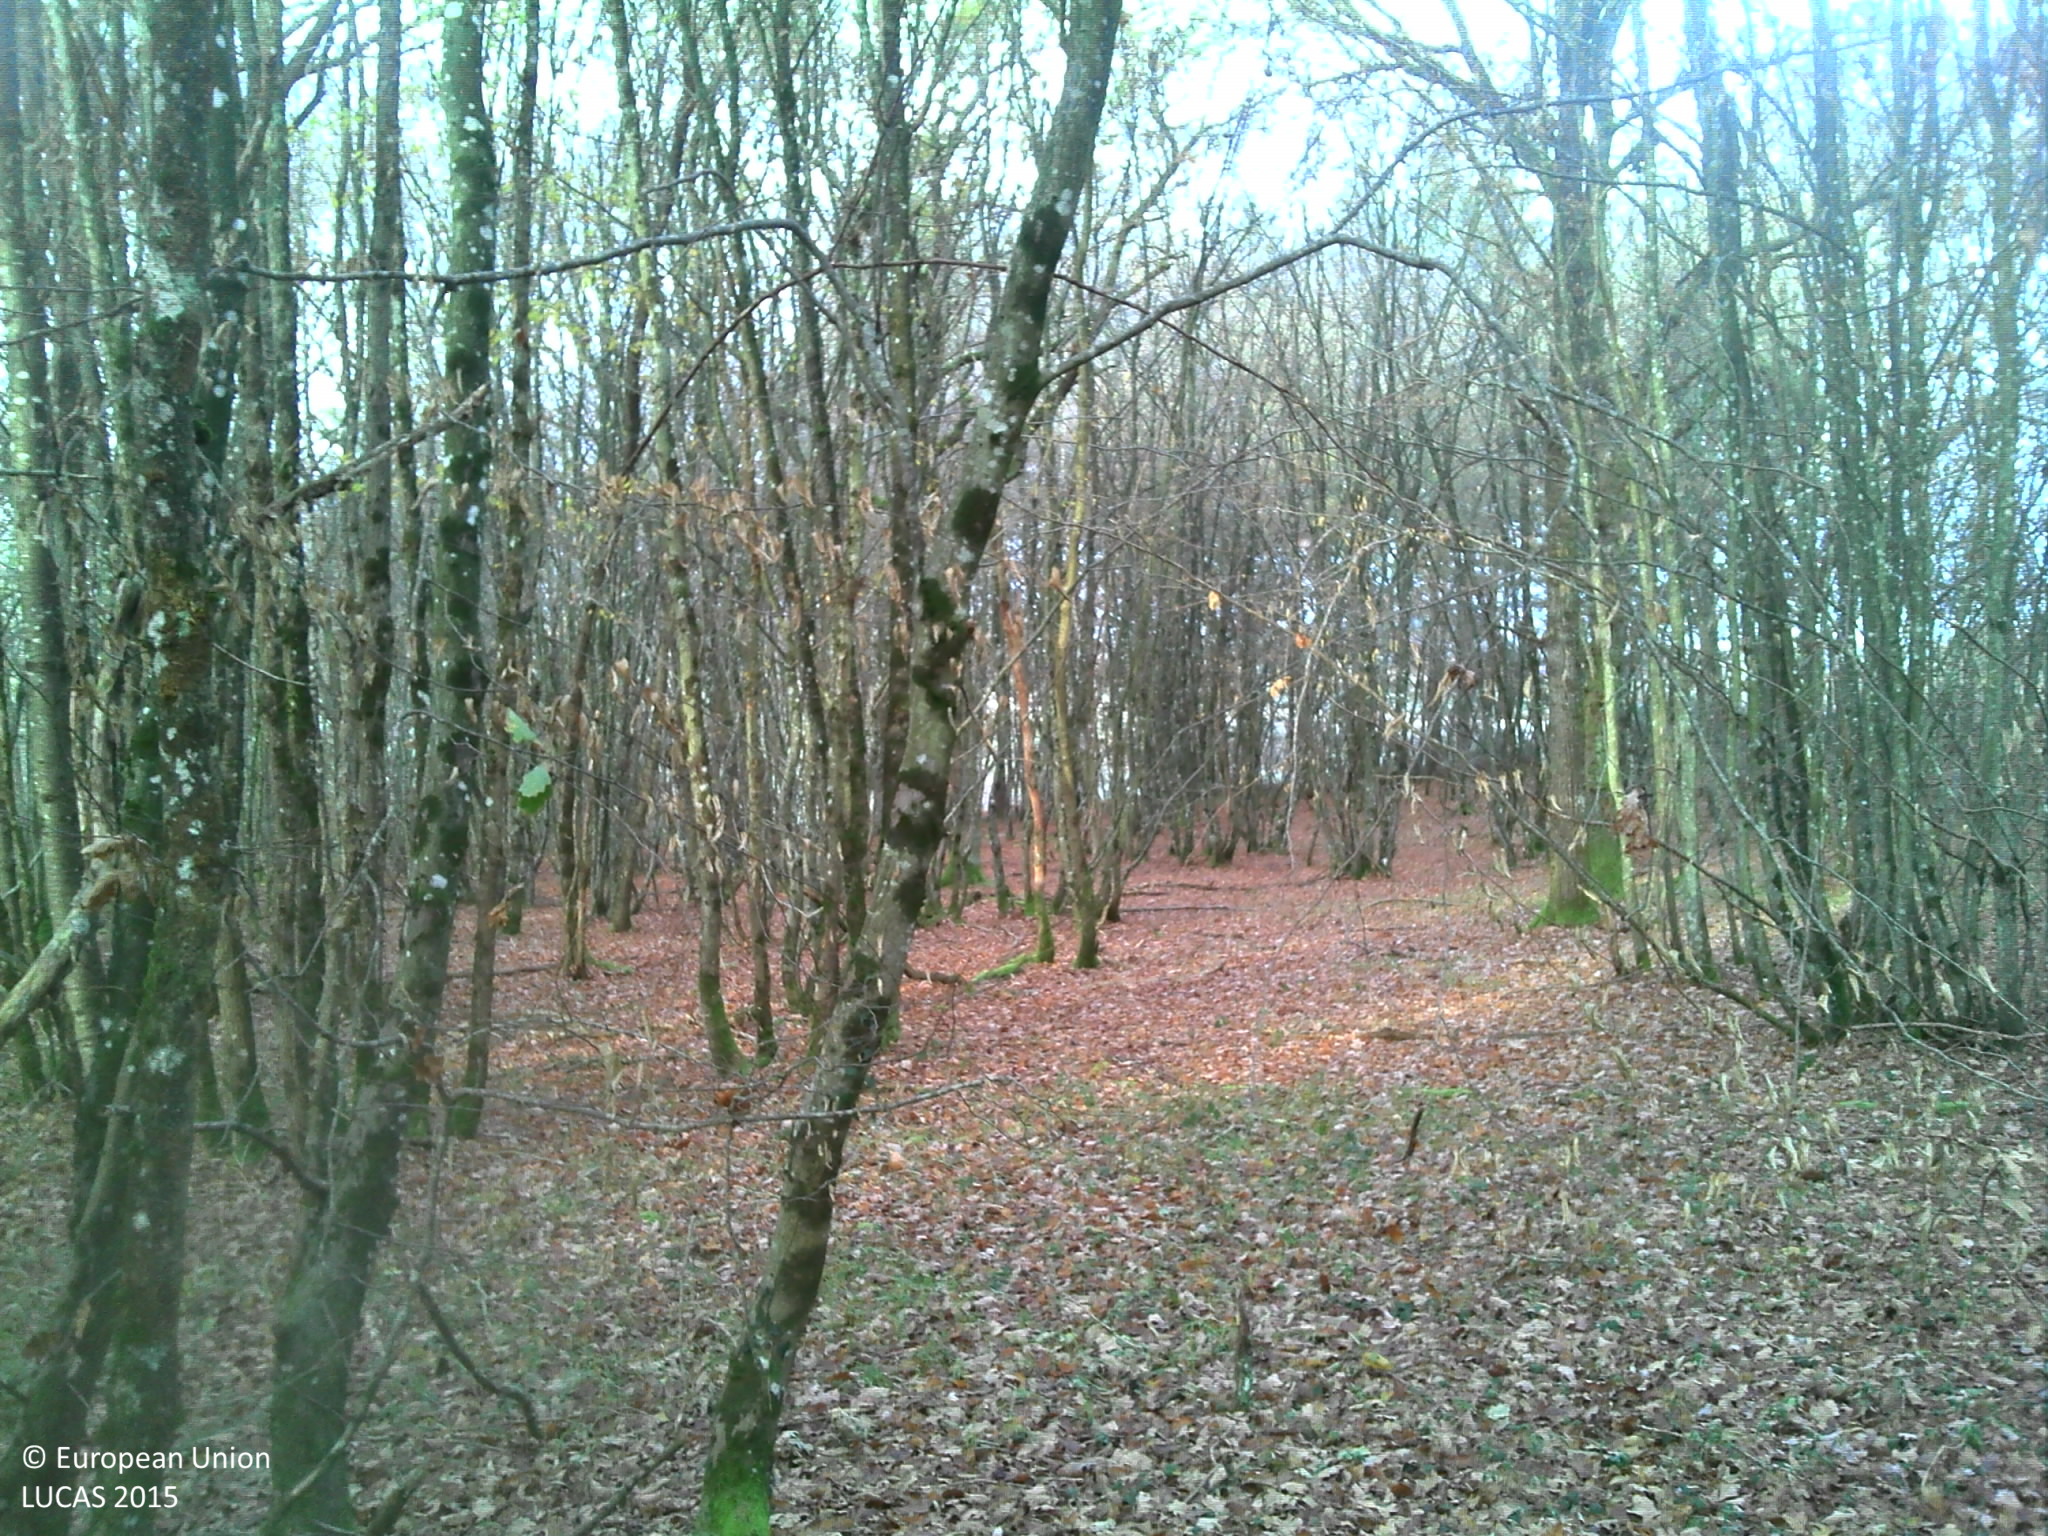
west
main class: Woodland
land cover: Broadleaved woodland
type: acidophilous oak and oak-birch forest
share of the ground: 50 - 75 %
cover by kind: broadleaved forest trees 70 %, unconsolidated bare surface 15 %, shrubs 5 %, herbaceous plants 5 %, lichens and mosses 5 %
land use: Forestry
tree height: > 5 m
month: November
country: FR
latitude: 46.2189
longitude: 3.6869
